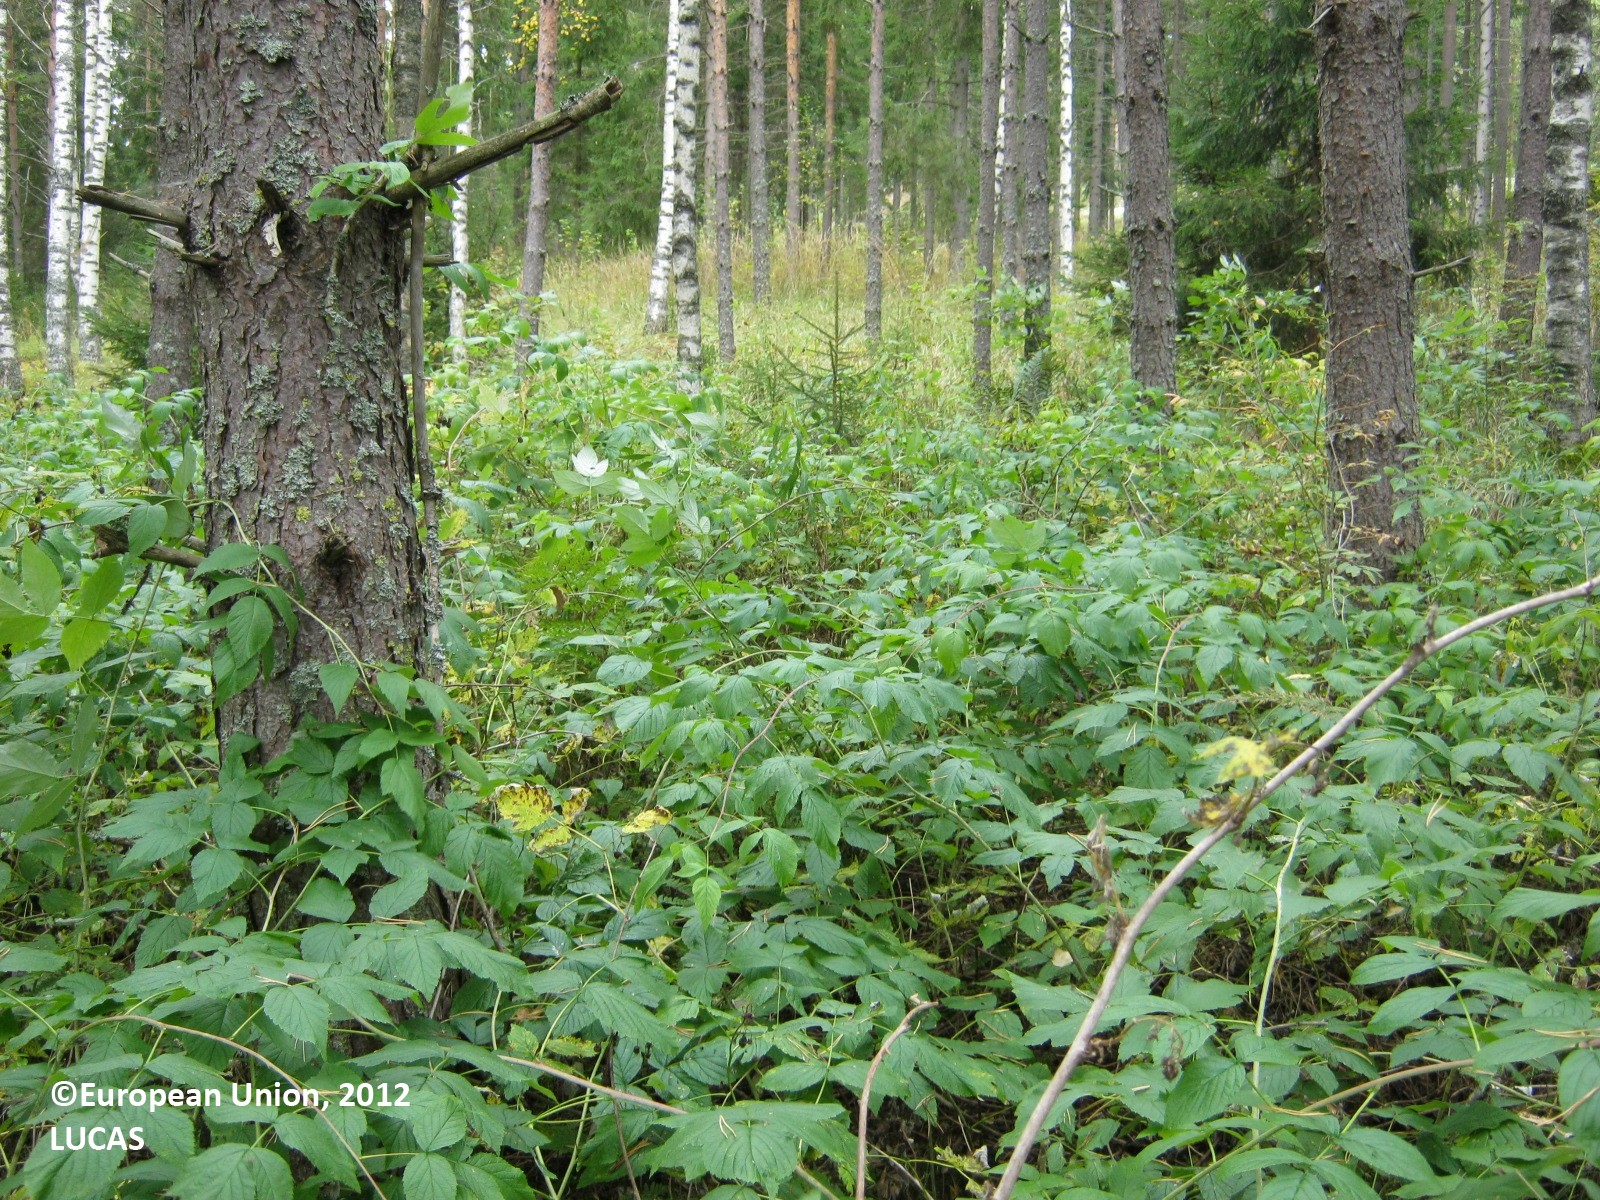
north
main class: Woodland
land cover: Spruce dominated mixed woodland
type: boreal forest
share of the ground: > 75 %
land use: Forestry
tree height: > 5 m
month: September
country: FI
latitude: 60.6845
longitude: 27.7902
